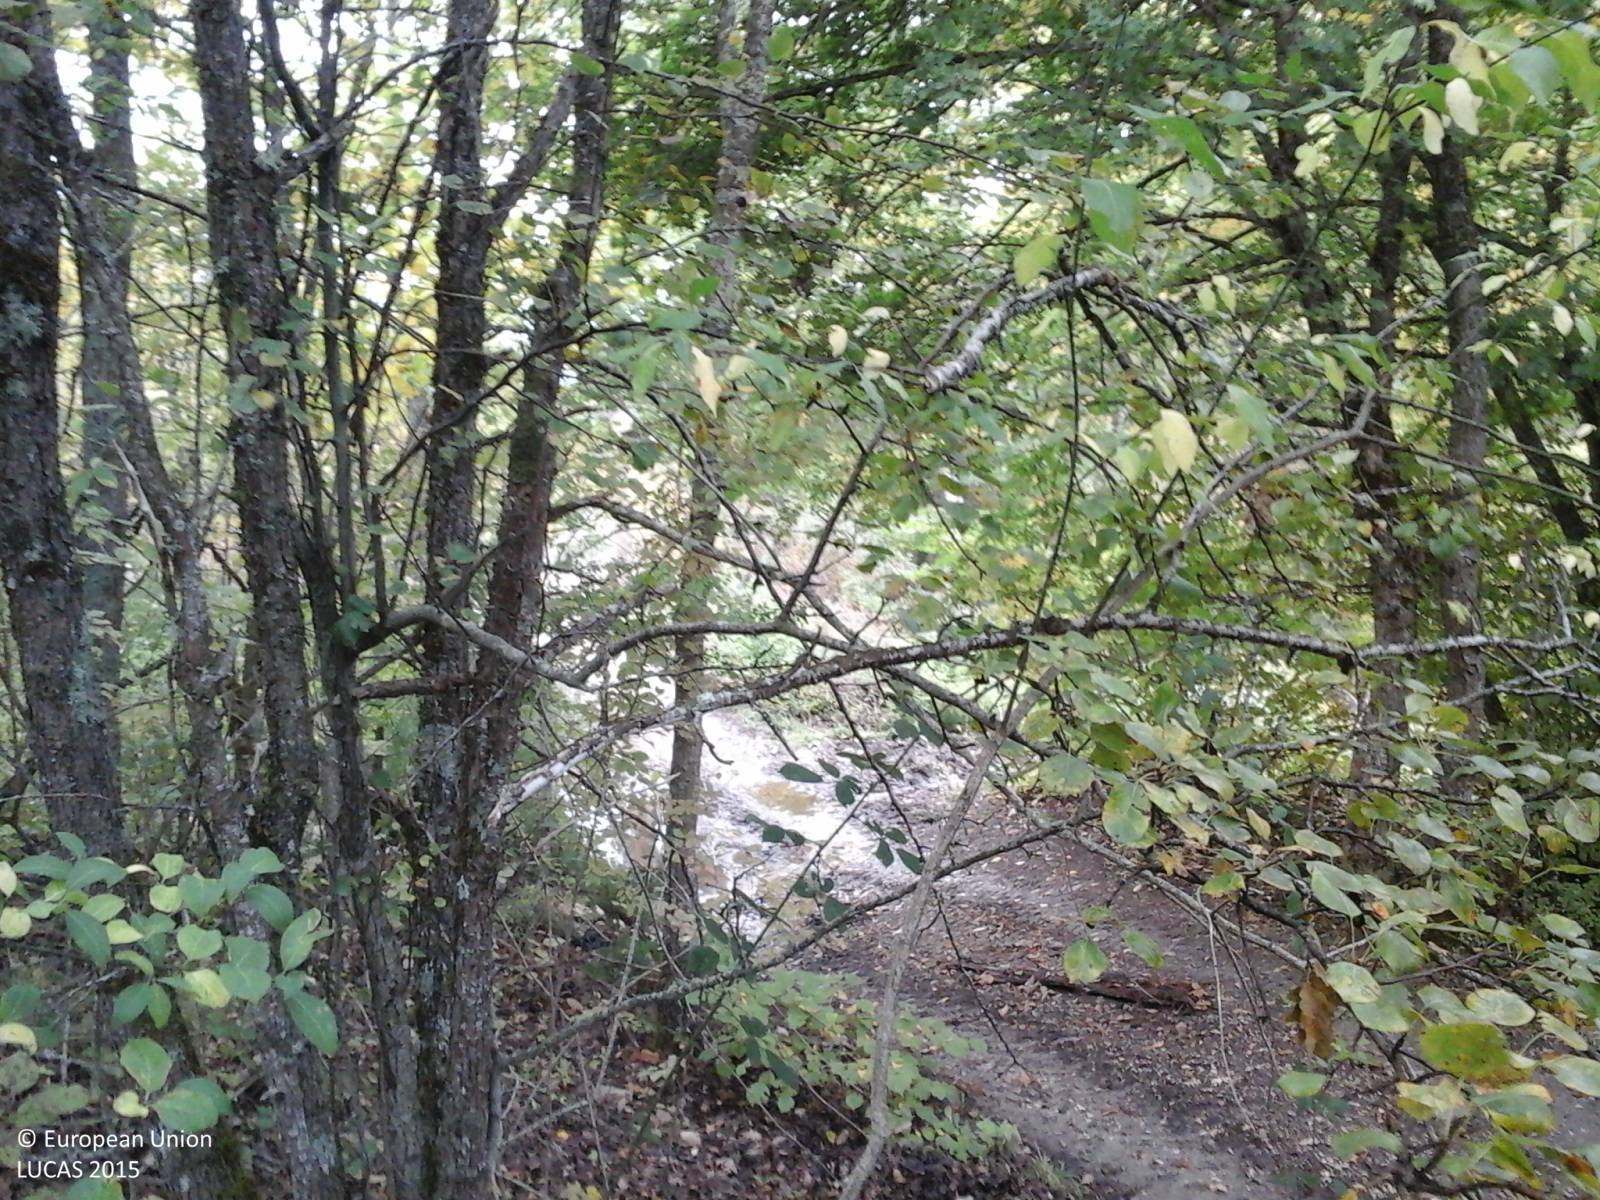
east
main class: Woodland
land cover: Broadleaved woodland
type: thermophilous deciduous forest
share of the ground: > 75 %
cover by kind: broadleaved forest trees 90 %, shrubs 10 %
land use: Forestry
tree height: > 5 m
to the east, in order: Broadleaved woodland; Tracks; Broadleaved woodland; Electric lines; Broadleaved woodland; Rivers and streams; Broadleaved woodland
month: October
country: IT
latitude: 42.6578
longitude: 13.1986
